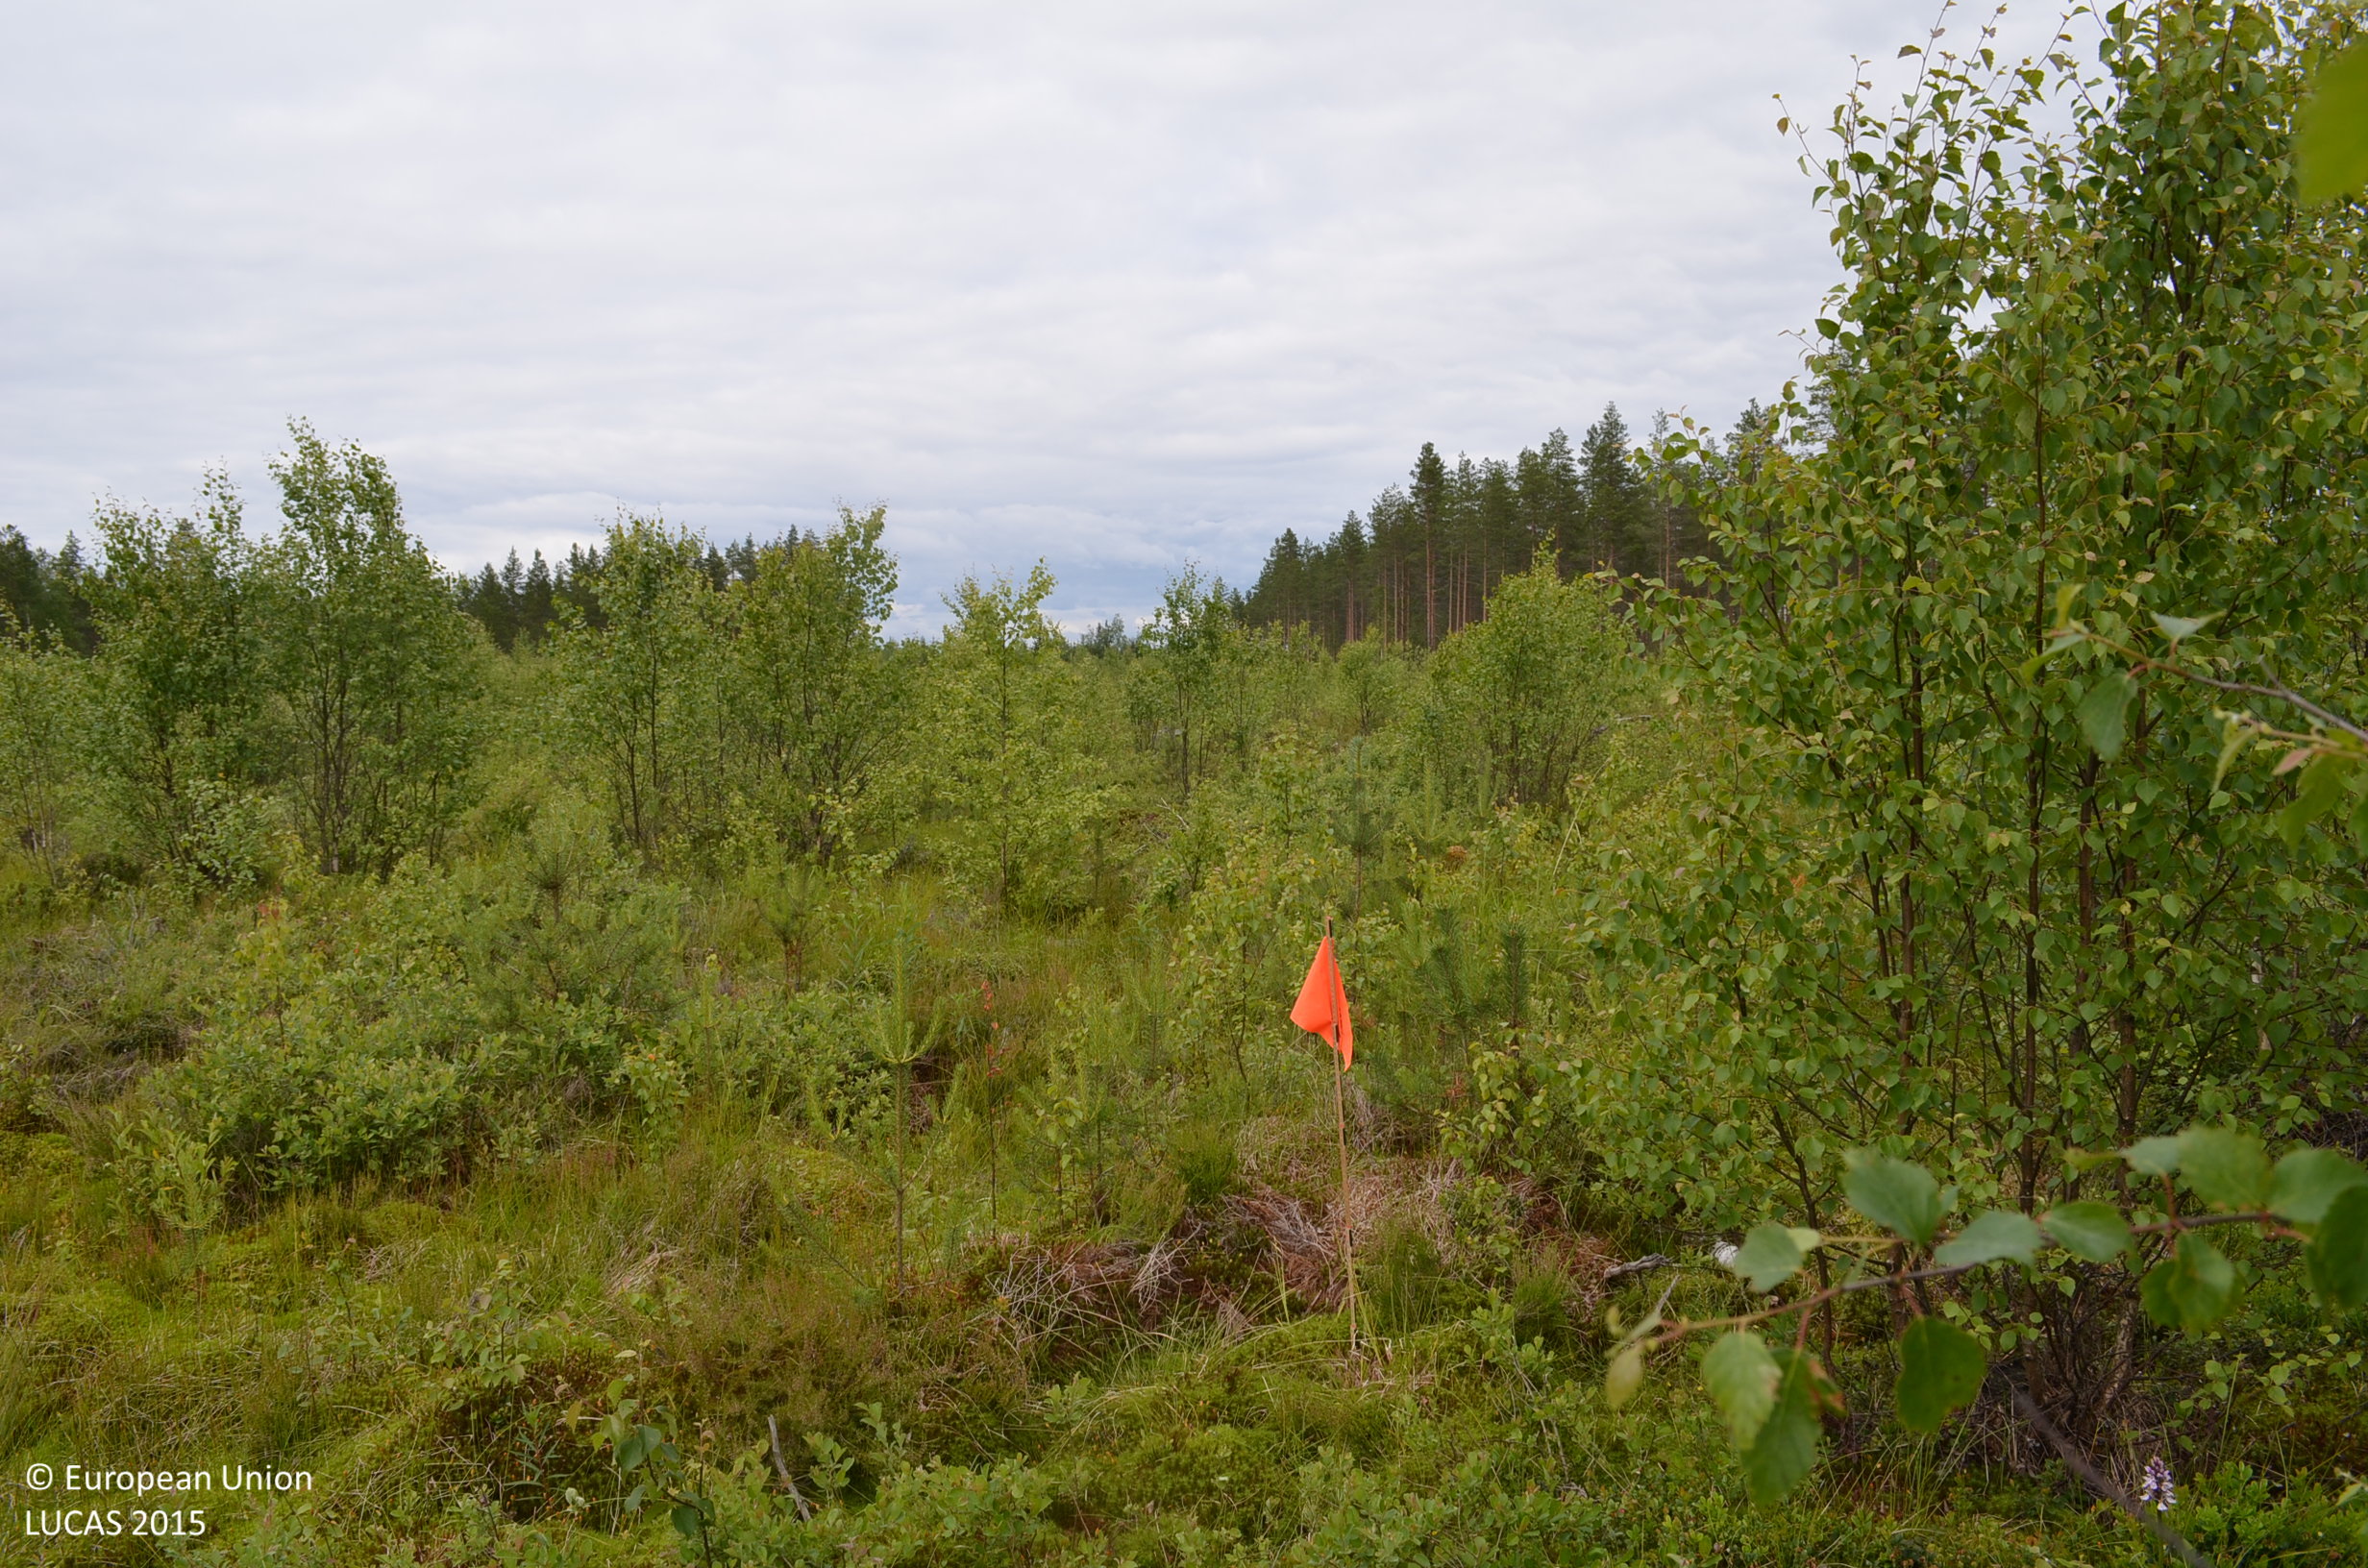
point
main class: Woodland
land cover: Pine dominated mixed woodland
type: boreal forest
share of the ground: 25 - 50 %
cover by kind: shrubs 35 %, broadleaved forest trees 25 %, herbaceous plants 15 %, coniferous forest trees 10 %, lichens and mosses 10 %
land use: Forestry
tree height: < 5 m
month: July
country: FI
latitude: 62.2932
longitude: 23.5107
